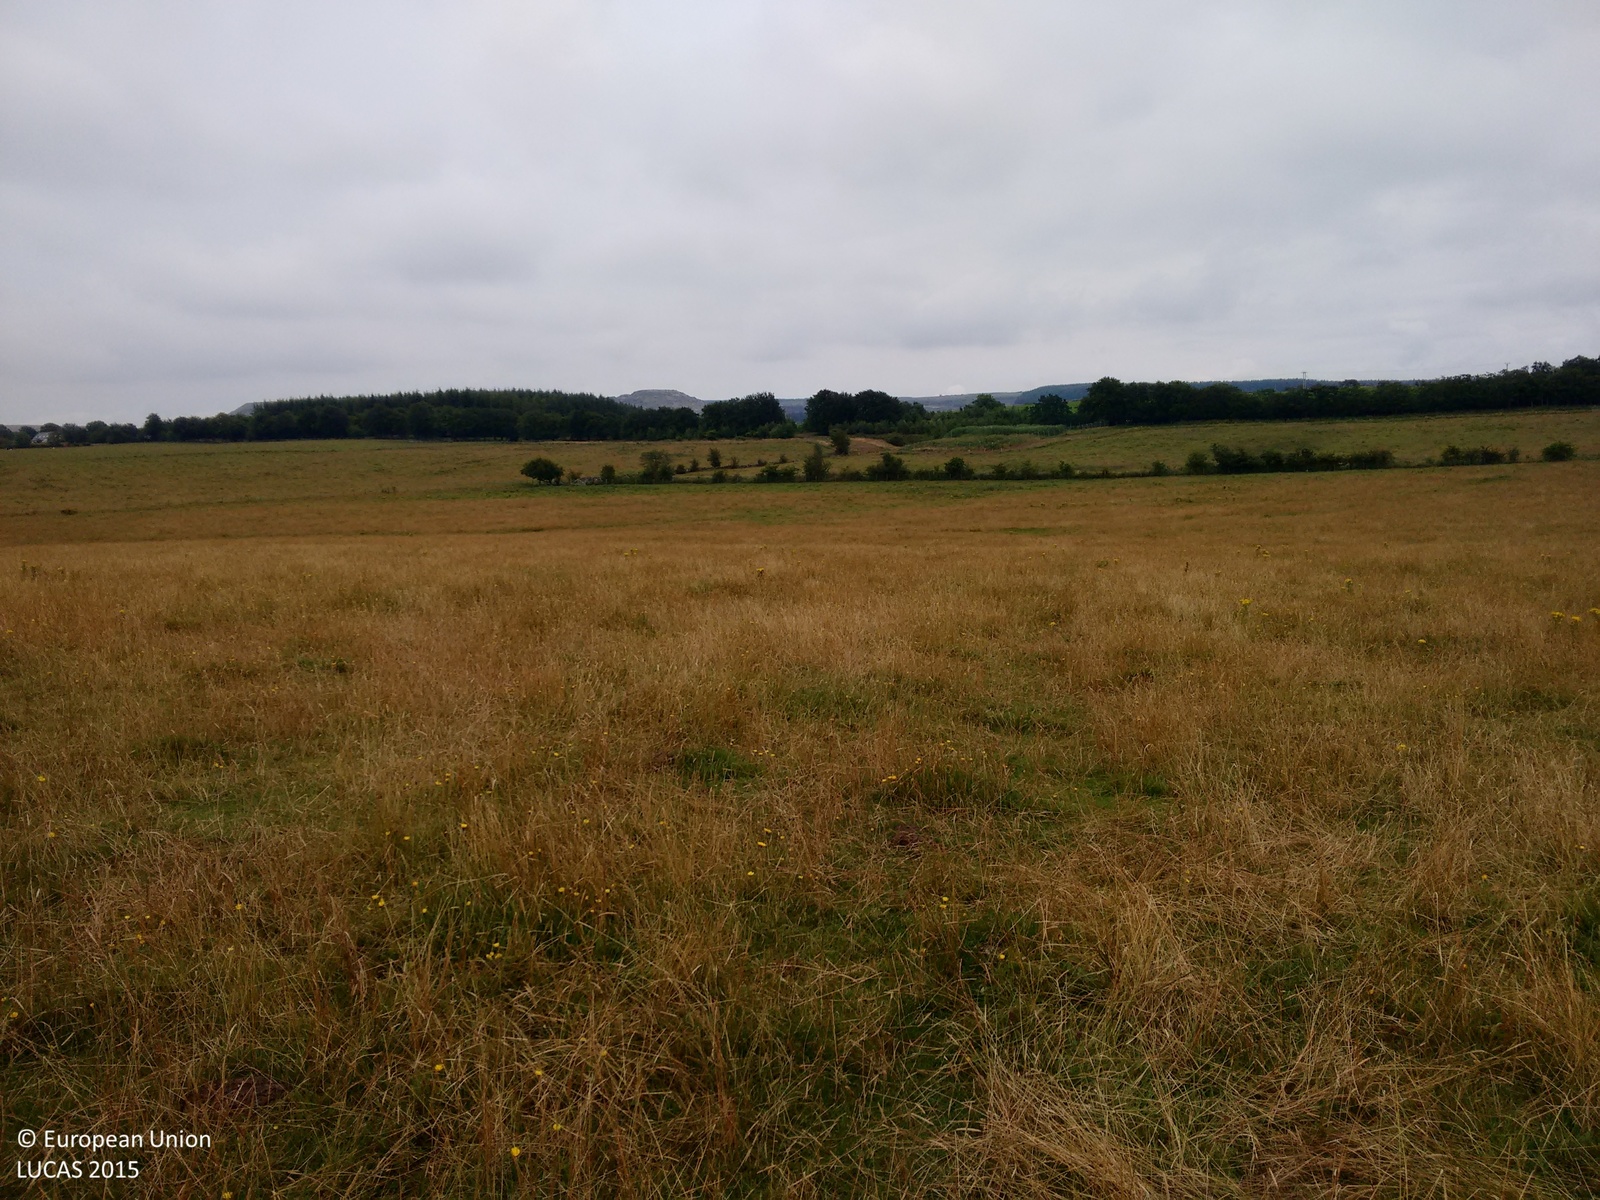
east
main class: Grassland
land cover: Grassland without tree/shrub cover
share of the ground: > 75 %
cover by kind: herbaceous plants 100 %
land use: Agriculture (excluding fallow land and kitchen gardens)
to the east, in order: Grassland without tree/shrub cover; Rivers and streams; Grass margins; Fences; Grassland without tree/shrub cover
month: August
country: GB
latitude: 55.4318
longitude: -4.3355
